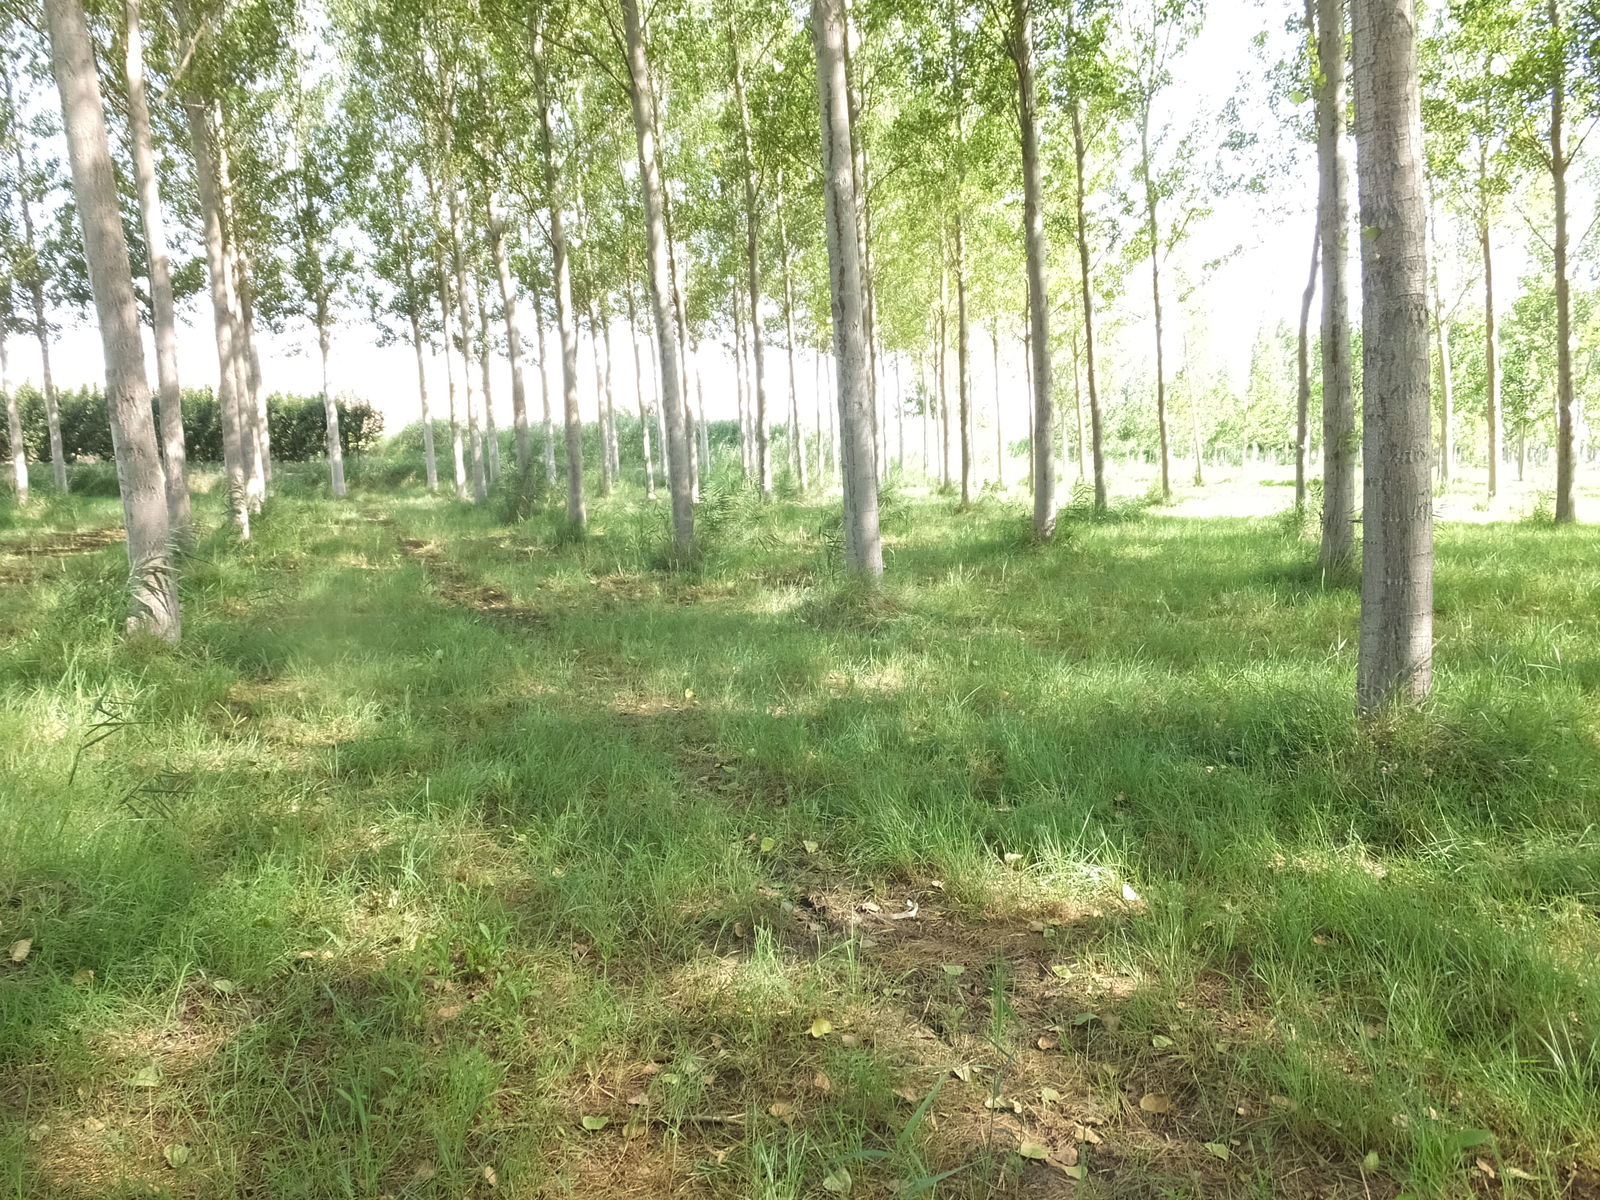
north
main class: Woodland
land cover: Broadleaved woodland
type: broadleaved evergreen forest
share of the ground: > 75 %
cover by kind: broadleaved forest trees 95 %, herbaceous plants 5 %
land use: Forestry
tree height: > 5 m
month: July
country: ES
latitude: 41.4741
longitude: 0.4441
